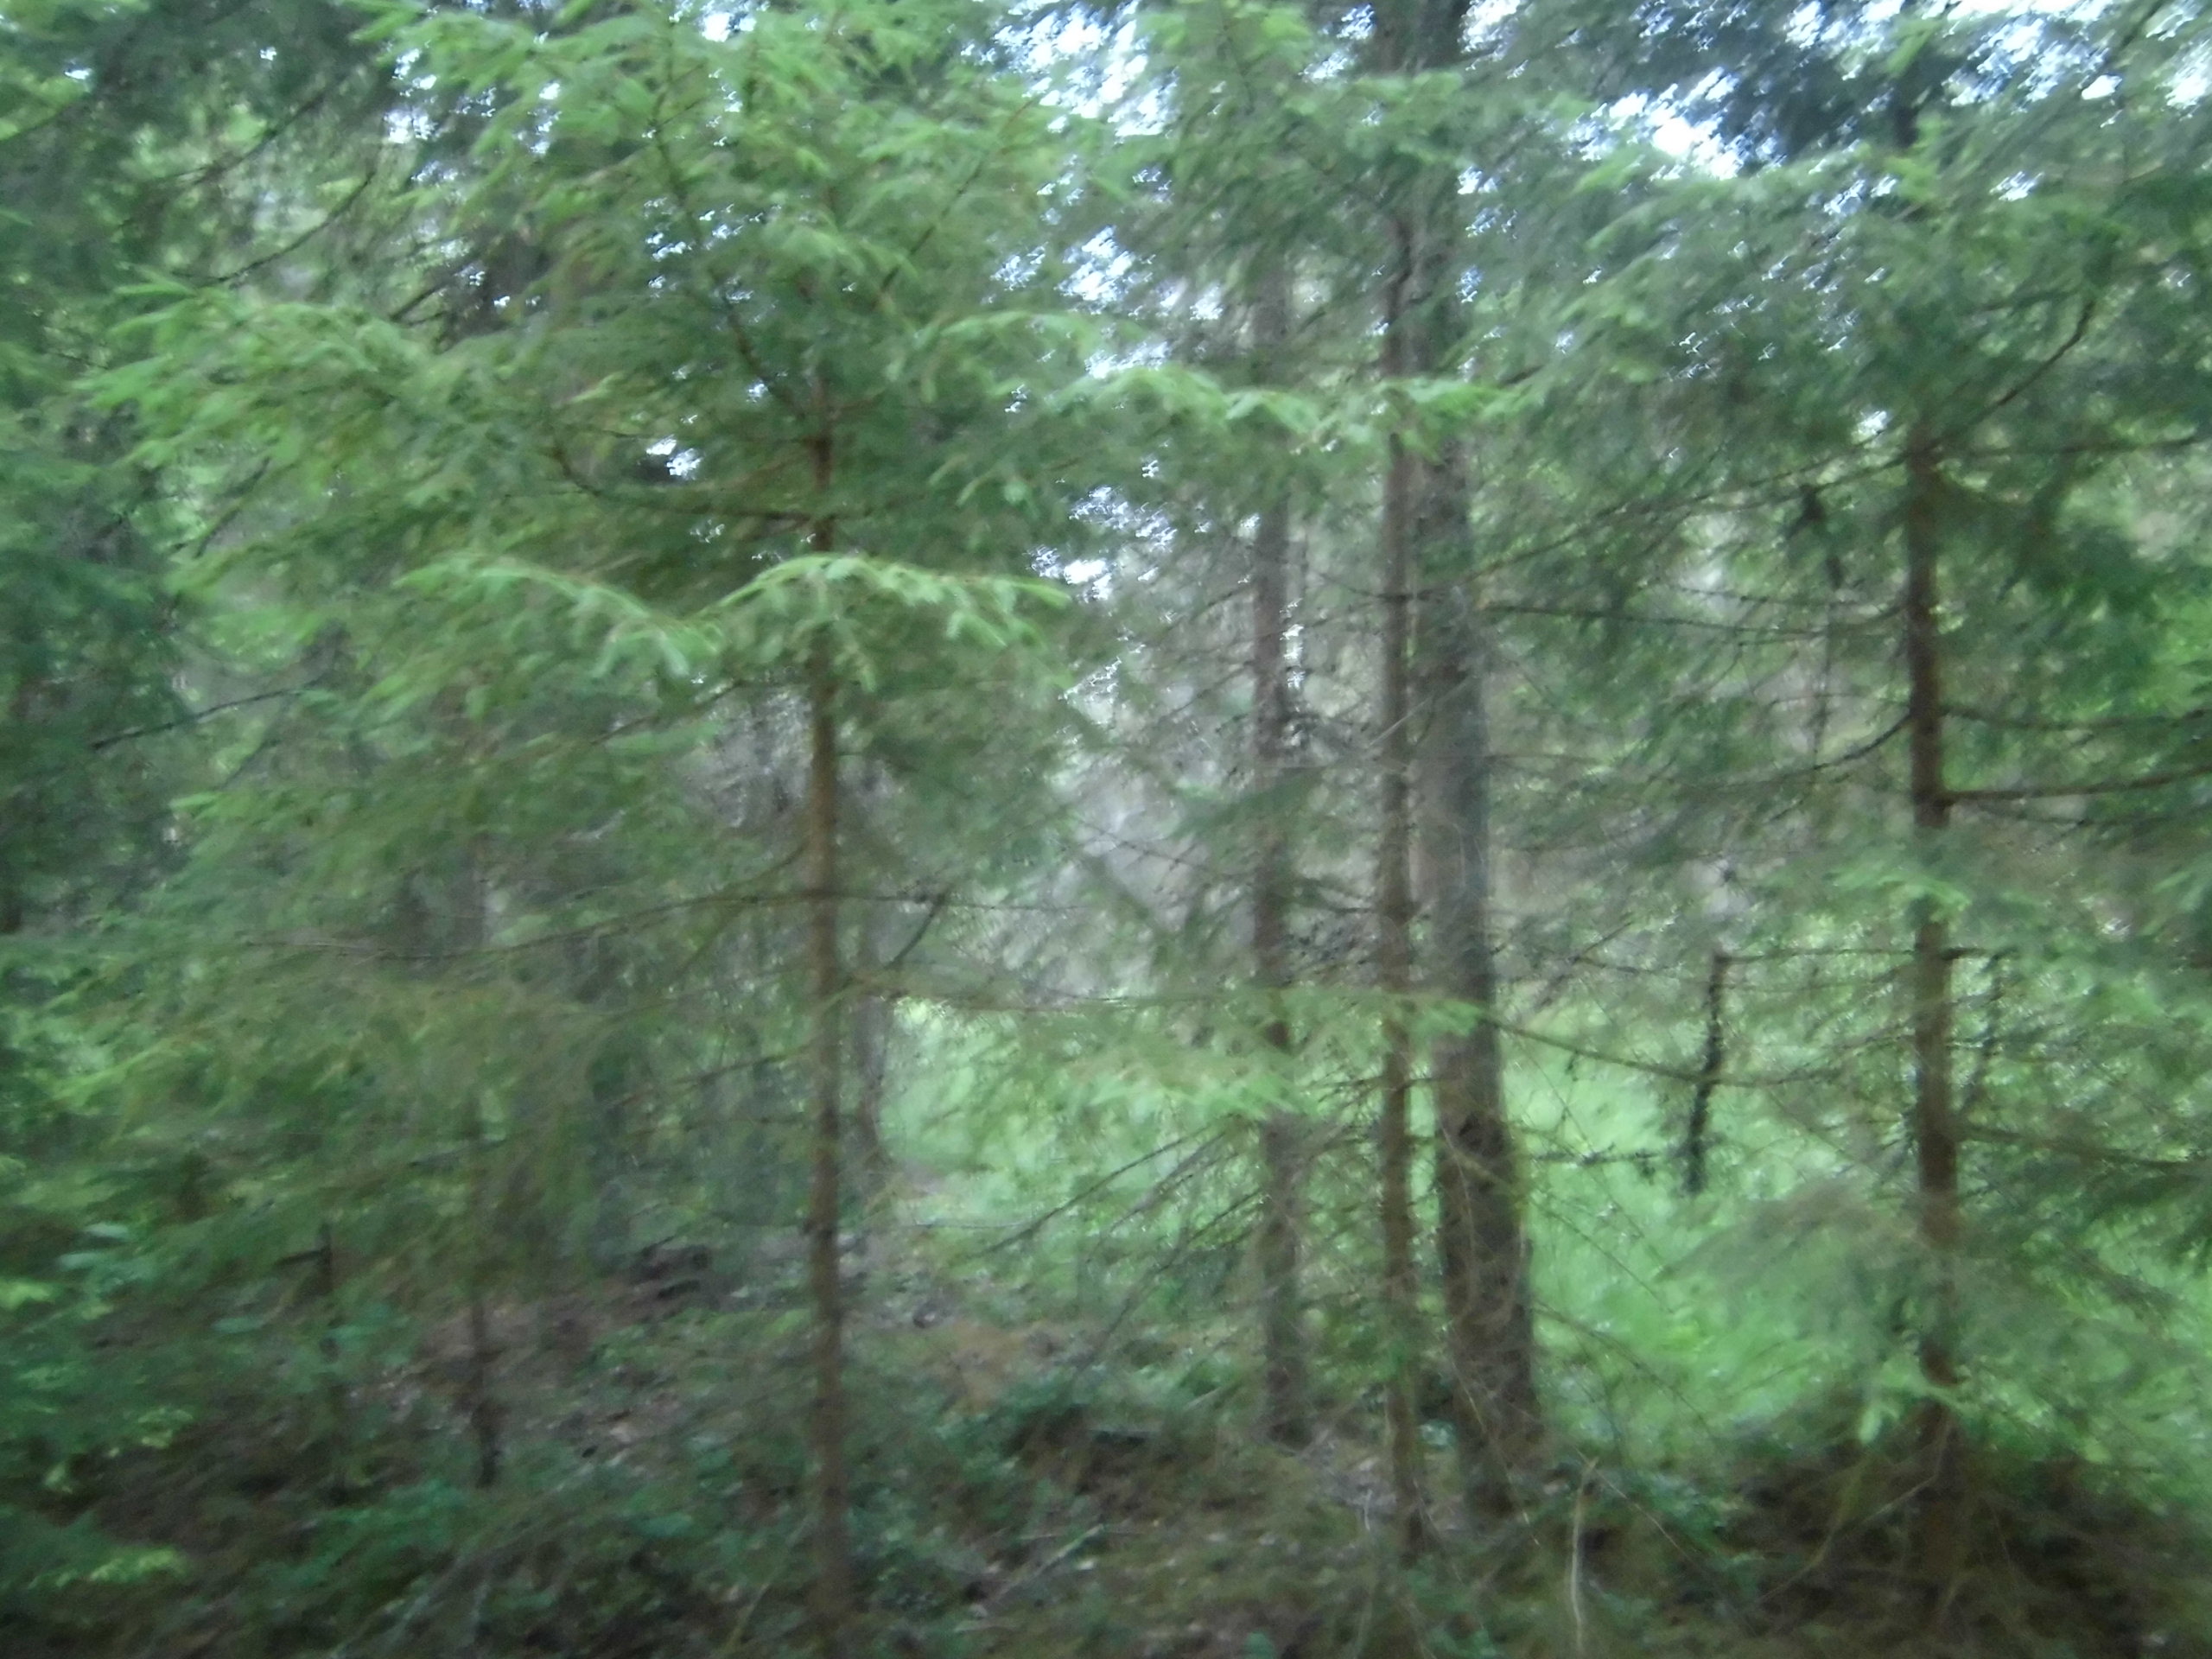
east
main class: Woodland
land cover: Spruce dominated coniferous woodland
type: boreal forest
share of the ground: 50 - 75 %
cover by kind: coniferous forest trees 50 %, herbaceous plants 25 %, shrubs 15 %, broadleaved forest trees 10 %
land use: Forestry
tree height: > 5 m
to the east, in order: Spruce dominated coniferous woodland; Spruce dominated mixed woodland; Spruce dominated coniferous woodland; Ditches and canals; Spruce dominated coniferous woodland; Ditches and canals; Spruce dominated coniferous woodland; Spruce dominated mixed woodland; Broadleaved woodland; Electric lines; Broadleaved woodland; Spruce dominated mixed woodland; Grassland with sparse tree/shrub cover; Spruce dominated mixed woodland; Spruce dominated coniferous woodland; Pine dominated coniferous woodland
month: July
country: SE
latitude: 57.2836
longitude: 14.8902
